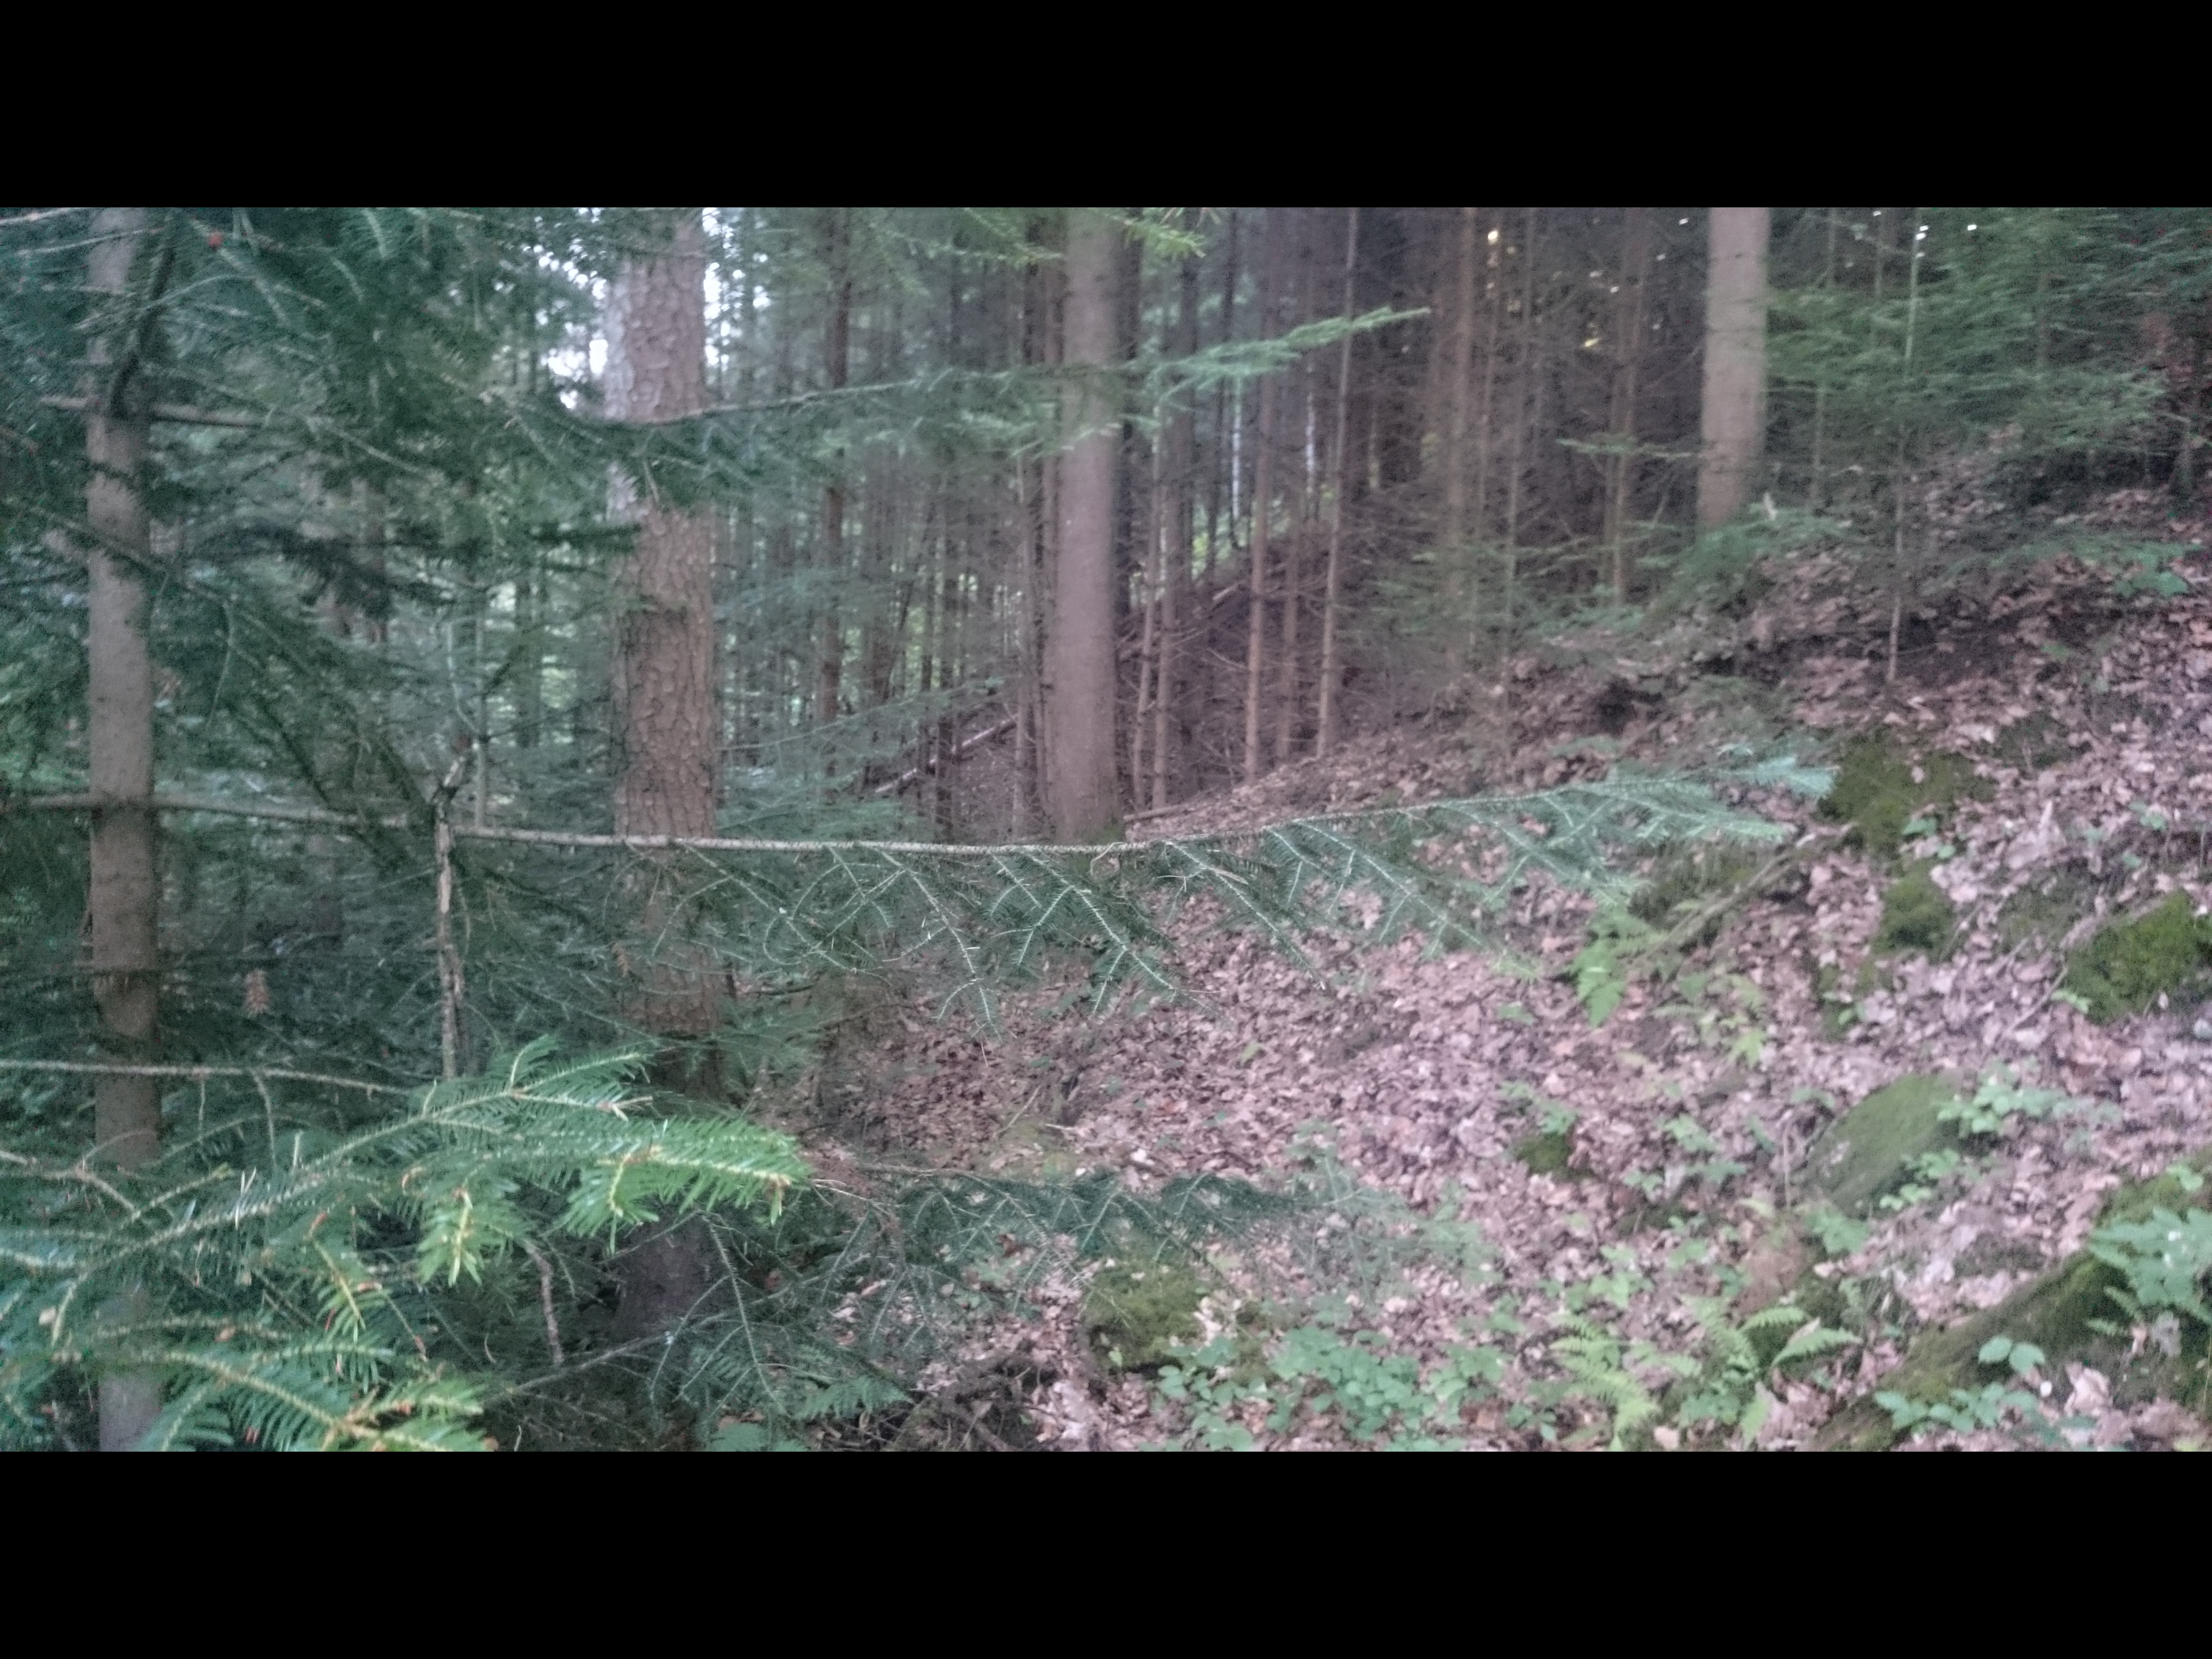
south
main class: Woodland
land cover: Spruce dominated mixed woodland
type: hemiboreal forest and nemoral coniferous forest and mixed broadleaved-coniferous forest
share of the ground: > 75 %
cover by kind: coniferous forest trees 75 %, broadleaved forest trees 25 %
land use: Forestry
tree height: > 5 m
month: July
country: AT
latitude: 47.2823
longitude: 15.6991
